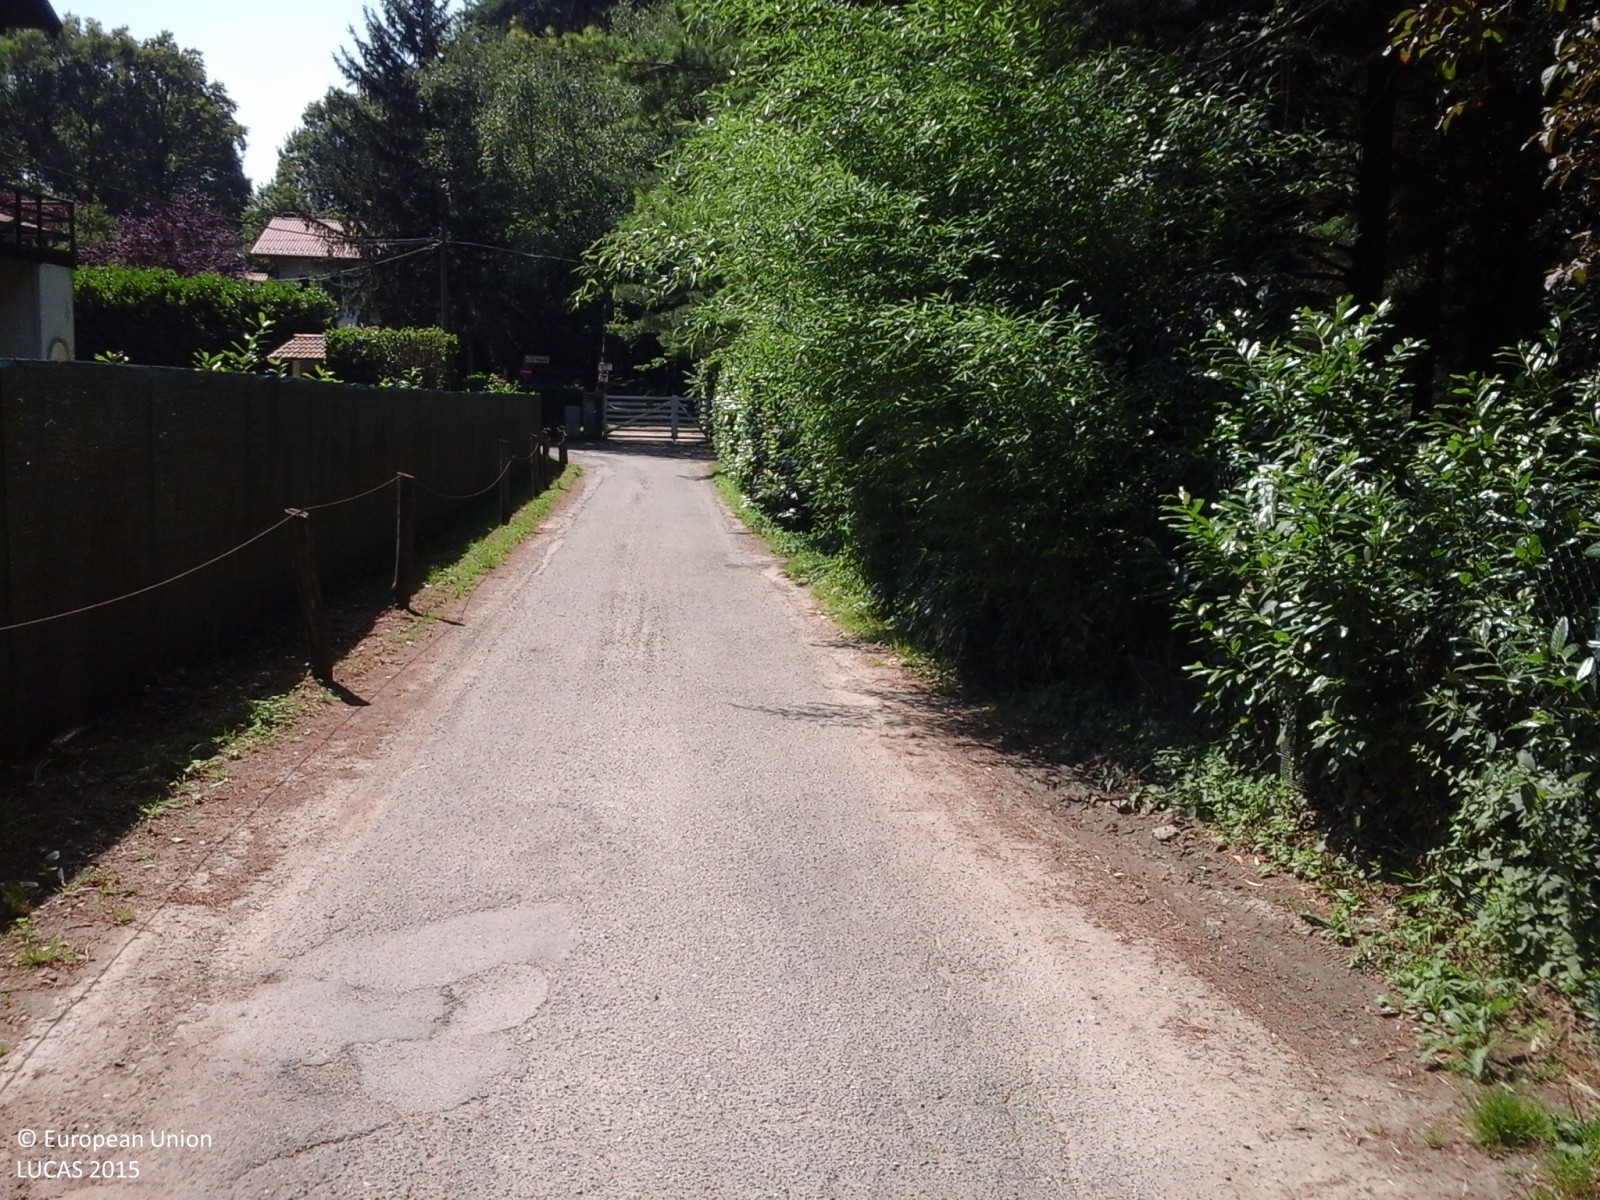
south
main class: Woodland
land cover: Pine dominated coniferous woodland
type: coniferous forest of the mediterranean region
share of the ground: > 75 %
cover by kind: coniferous forest trees 90 %, unconsolidated bare surface 10 %
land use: Amenities, museums, leisure
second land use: Sport
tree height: > 5 m
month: June
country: IT
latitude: 45.6770
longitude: 8.7311
